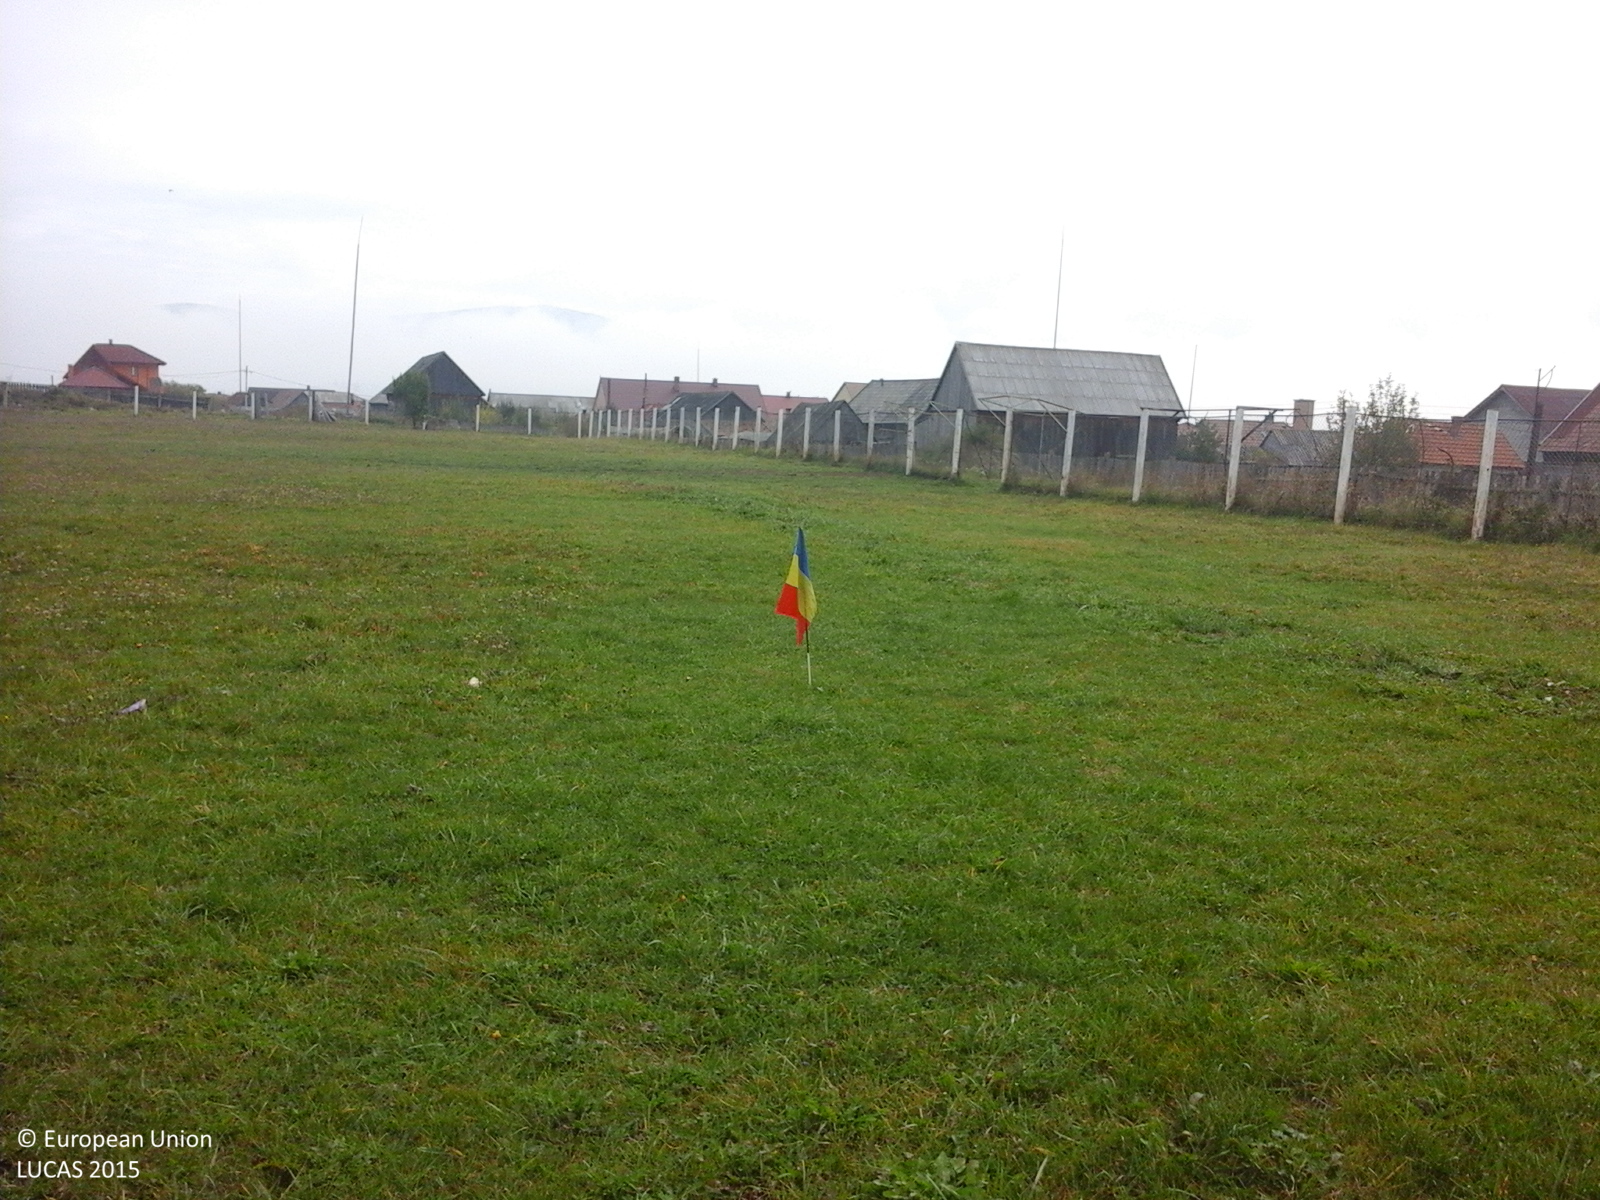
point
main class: Grassland
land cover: Grassland without tree/shrub cover
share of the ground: > 75 %
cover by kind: herbaceous plants 100 %
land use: Agriculture (excluding fallow land and kitchen gardens)
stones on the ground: < 10 %
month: October
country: RO
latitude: 46.7957
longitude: 25.4516
